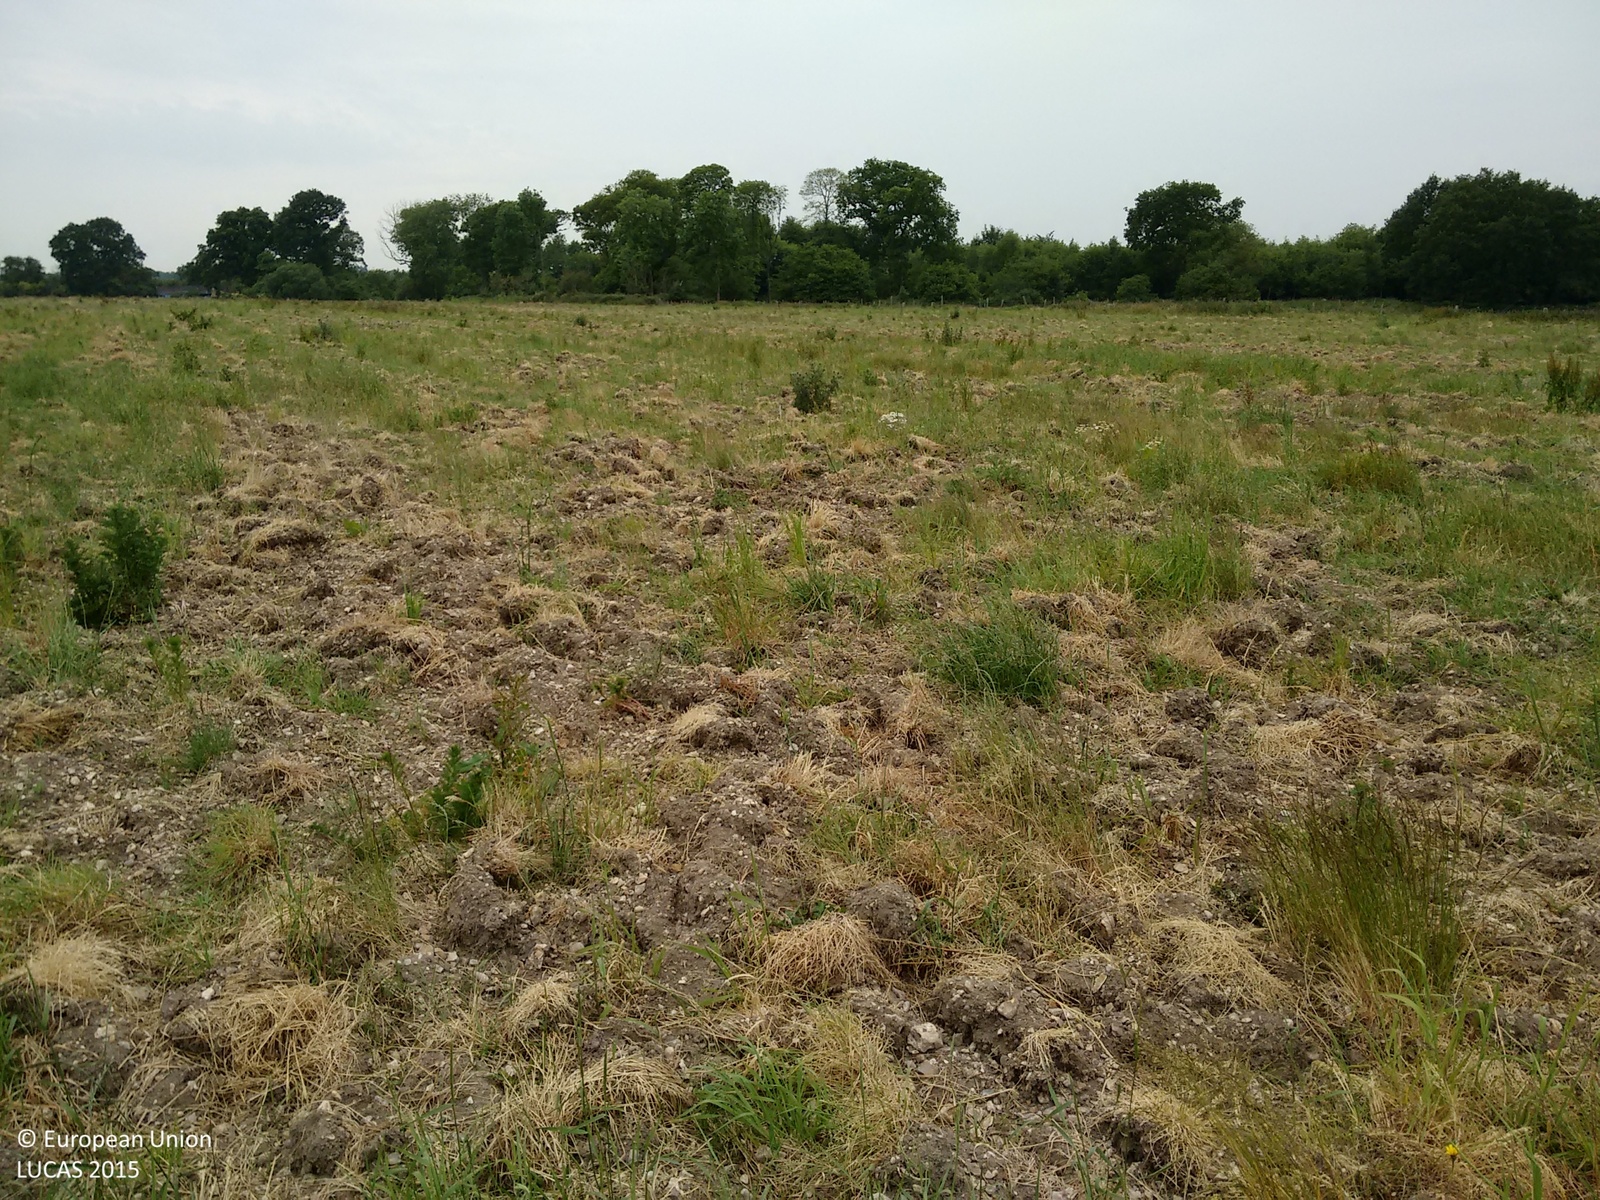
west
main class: Grassland
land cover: Grassland without tree/shrub cover
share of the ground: > 75 %
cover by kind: herbaceous plants 75 %, unconsolidated bare surface 25 %
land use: Agriculture (excluding fallow land and kitchen gardens)
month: June
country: GB
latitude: 51.4013
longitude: -1.0997
